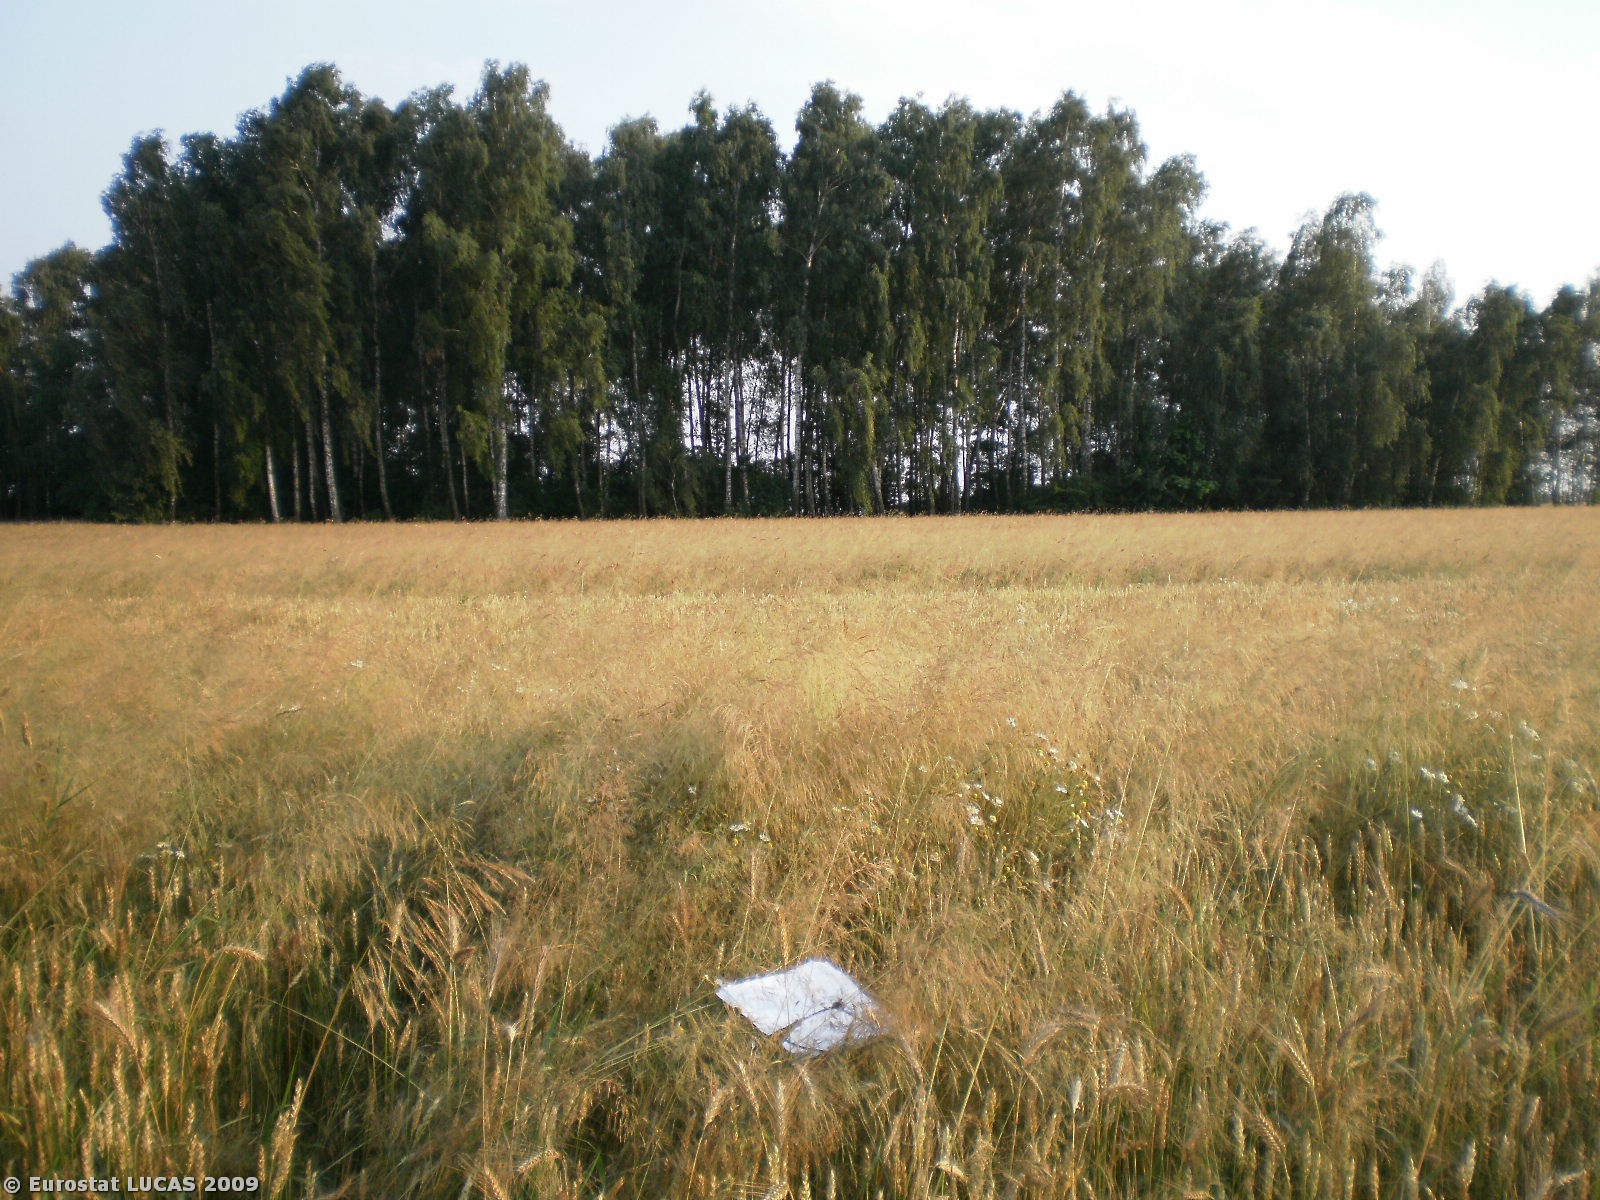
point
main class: Cropland
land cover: Common wheat
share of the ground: > 75 %
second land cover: Triticale
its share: < 10 %
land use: Agriculture (excluding fallow land and kitchen gardens)
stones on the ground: < 10 %
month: July
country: PL
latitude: 52.8744
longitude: 20.8734
